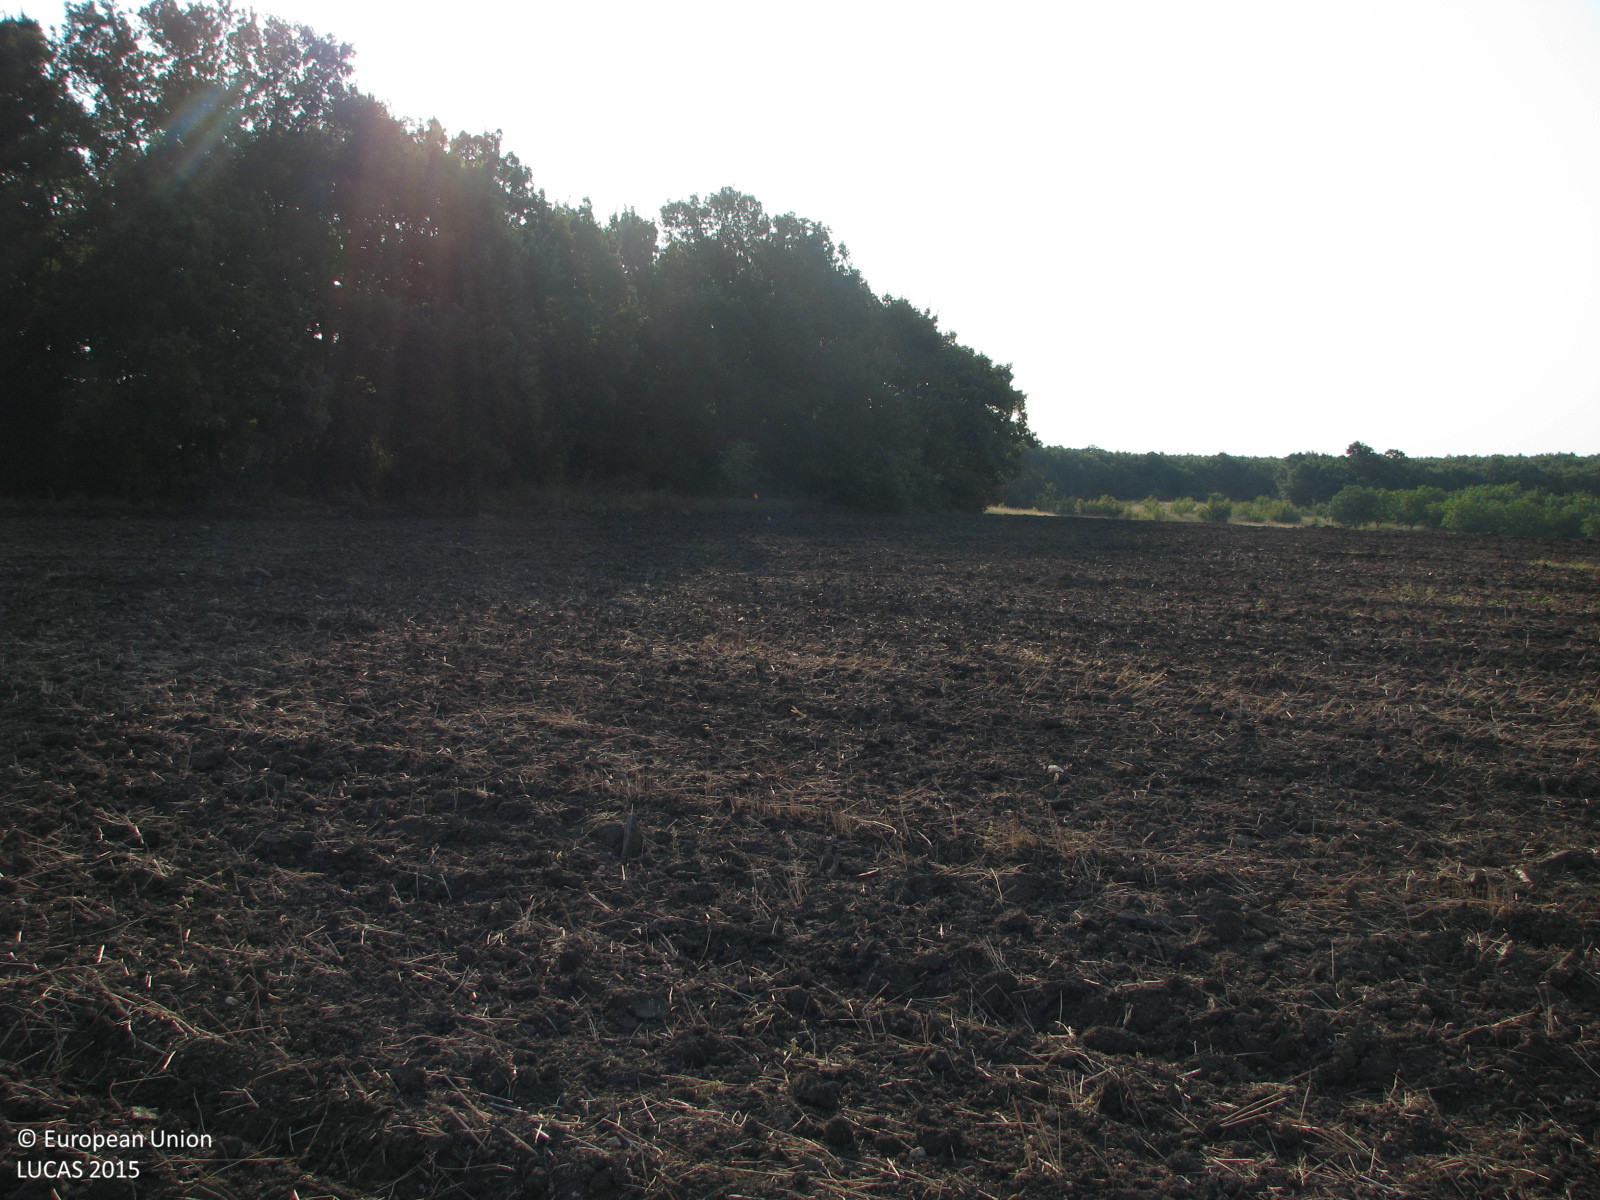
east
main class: Cropland
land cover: Other non-permanent industrial crops
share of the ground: < 10 %
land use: Agriculture (excluding fallow land and kitchen gardens)
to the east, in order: Other non-permanent industrial crops; Broadleaved woodland; Grassland with sparse tree/shrub cover; Broadleaved woodland; Paved roads, cycling and walking lanes; Broadleaved woodland
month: August
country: BG
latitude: 42.1821
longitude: 26.4439
